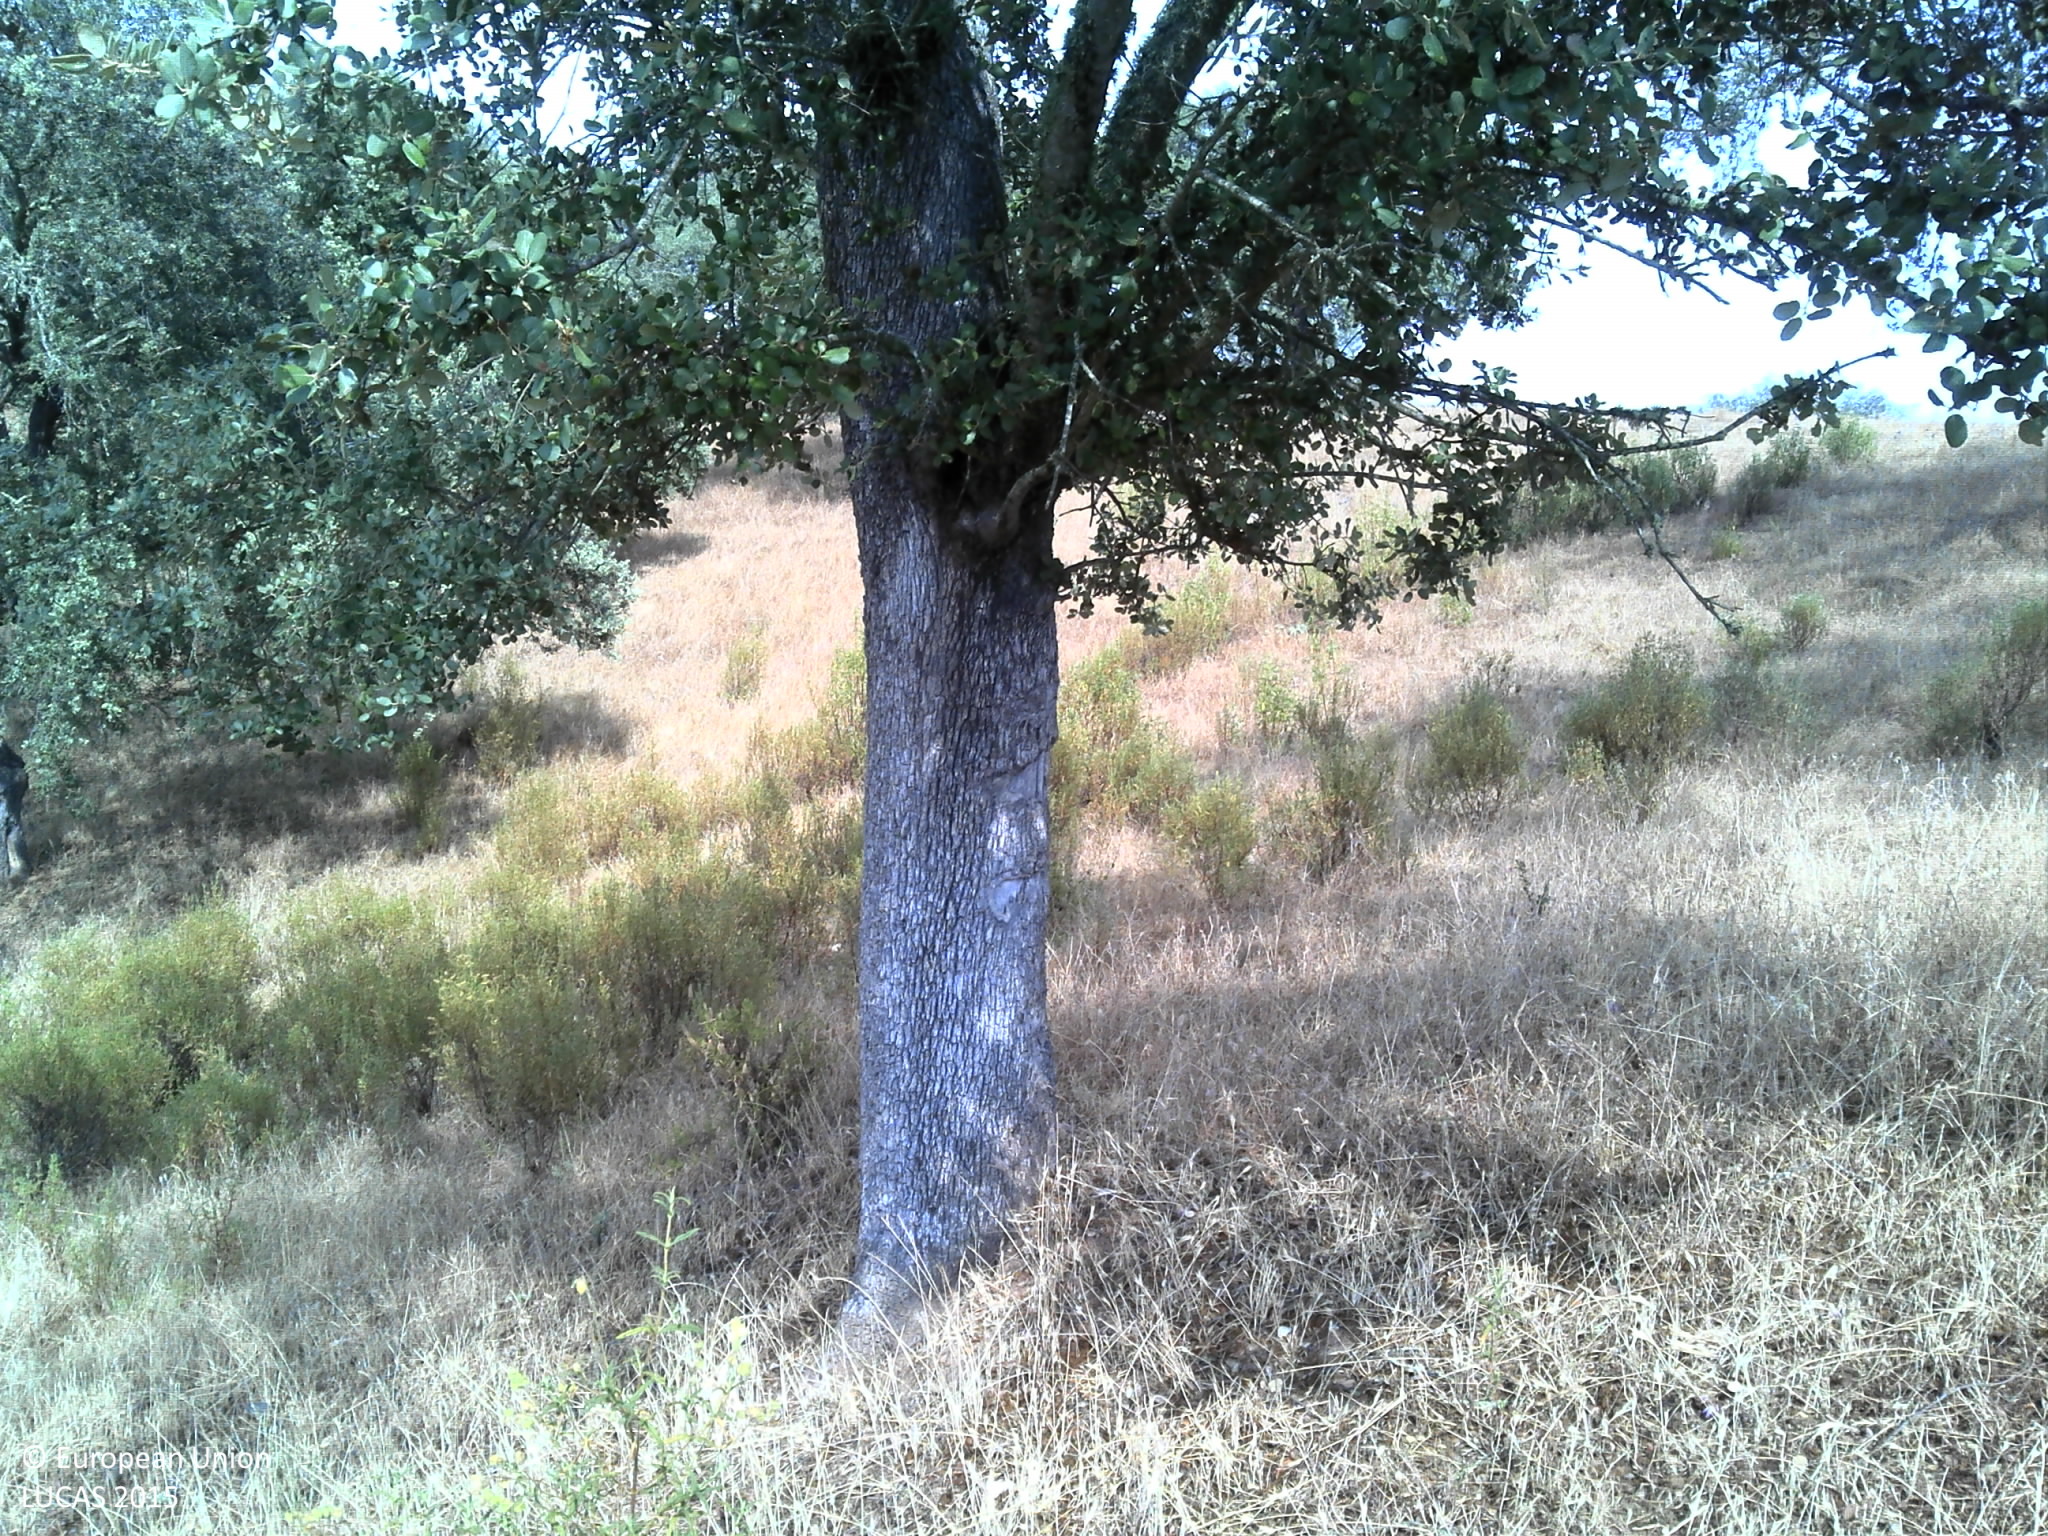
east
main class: Woodland
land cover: Broadleaved woodland
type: broadleaved evergreen forest
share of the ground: 25 - 50 %
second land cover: Grassland without tree/shrub cover
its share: 50 - 75 %
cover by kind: herbaceous plants 55 %, broadleaved forest trees 40 %, unconsolidated bare surface 5 %
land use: Forestry
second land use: Agriculture (excluding fallow land and kitchen gardens)
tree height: > 5 m
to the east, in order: Broadleaved woodland; Grassland without tree/shrub cover; Broadleaved woodland; Tracks; Broadleaved woodland; Tracks; Grassland without tree/shrub cover; Broadleaved woodland; Artificial constructions in urban areas
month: June
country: PT
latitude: 37.8409
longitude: -7.6439
